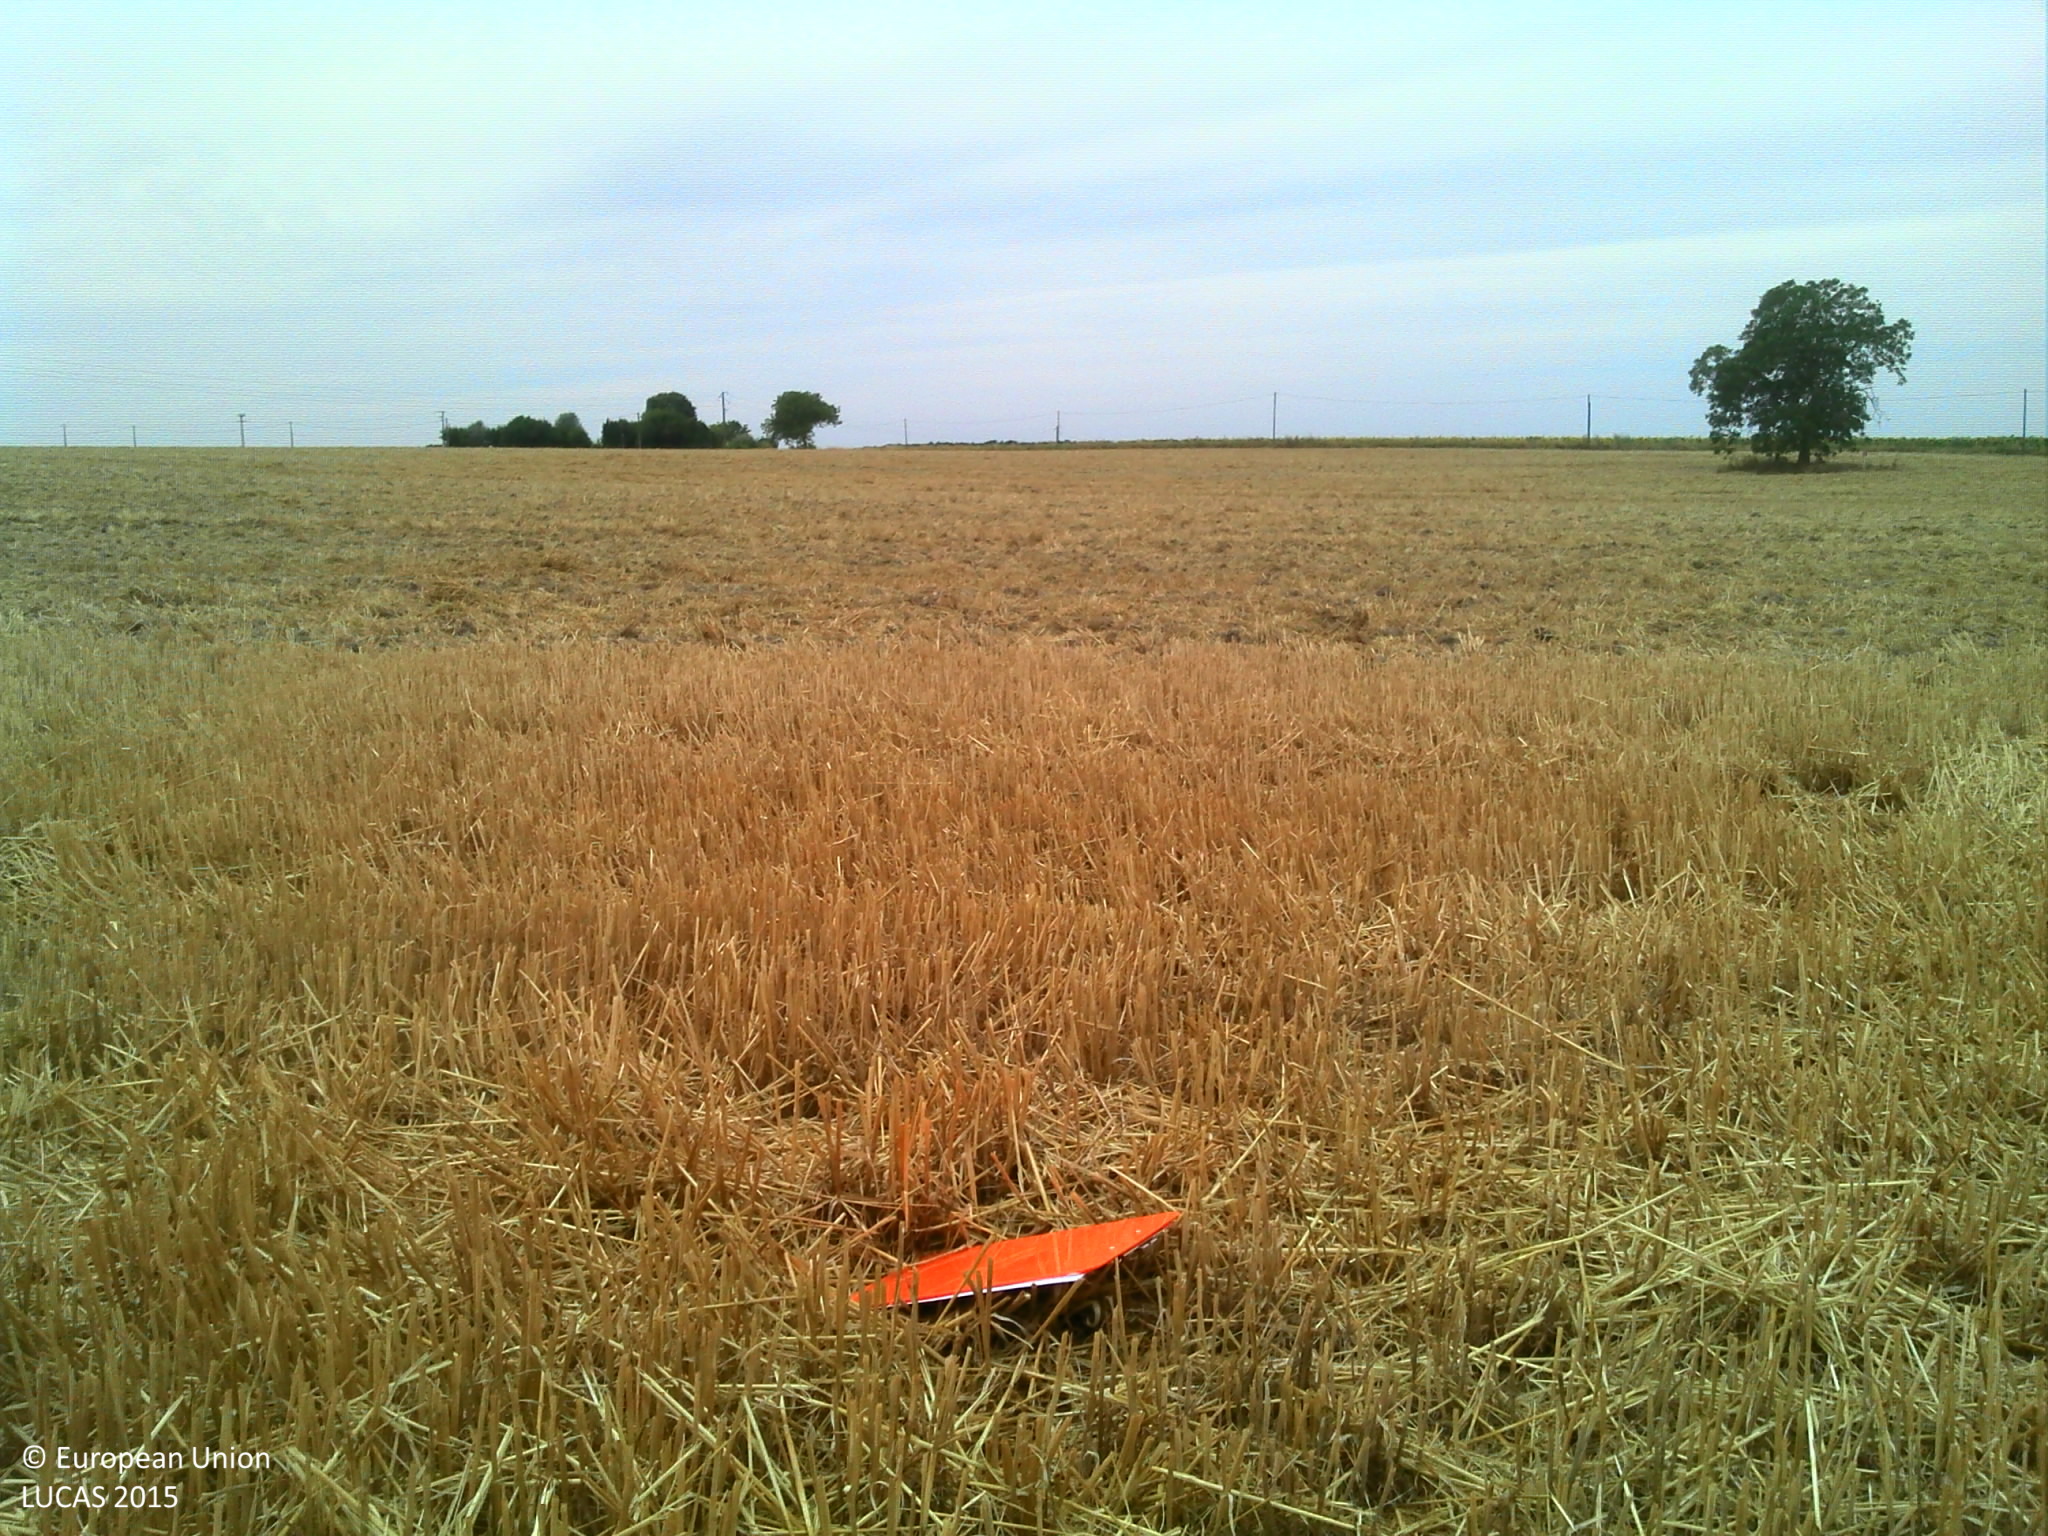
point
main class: Cropland
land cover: Common wheat
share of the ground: > 75 %
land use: Agriculture (excluding fallow land and kitchen gardens)
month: July
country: FR
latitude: 47.1125
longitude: 0.3716
